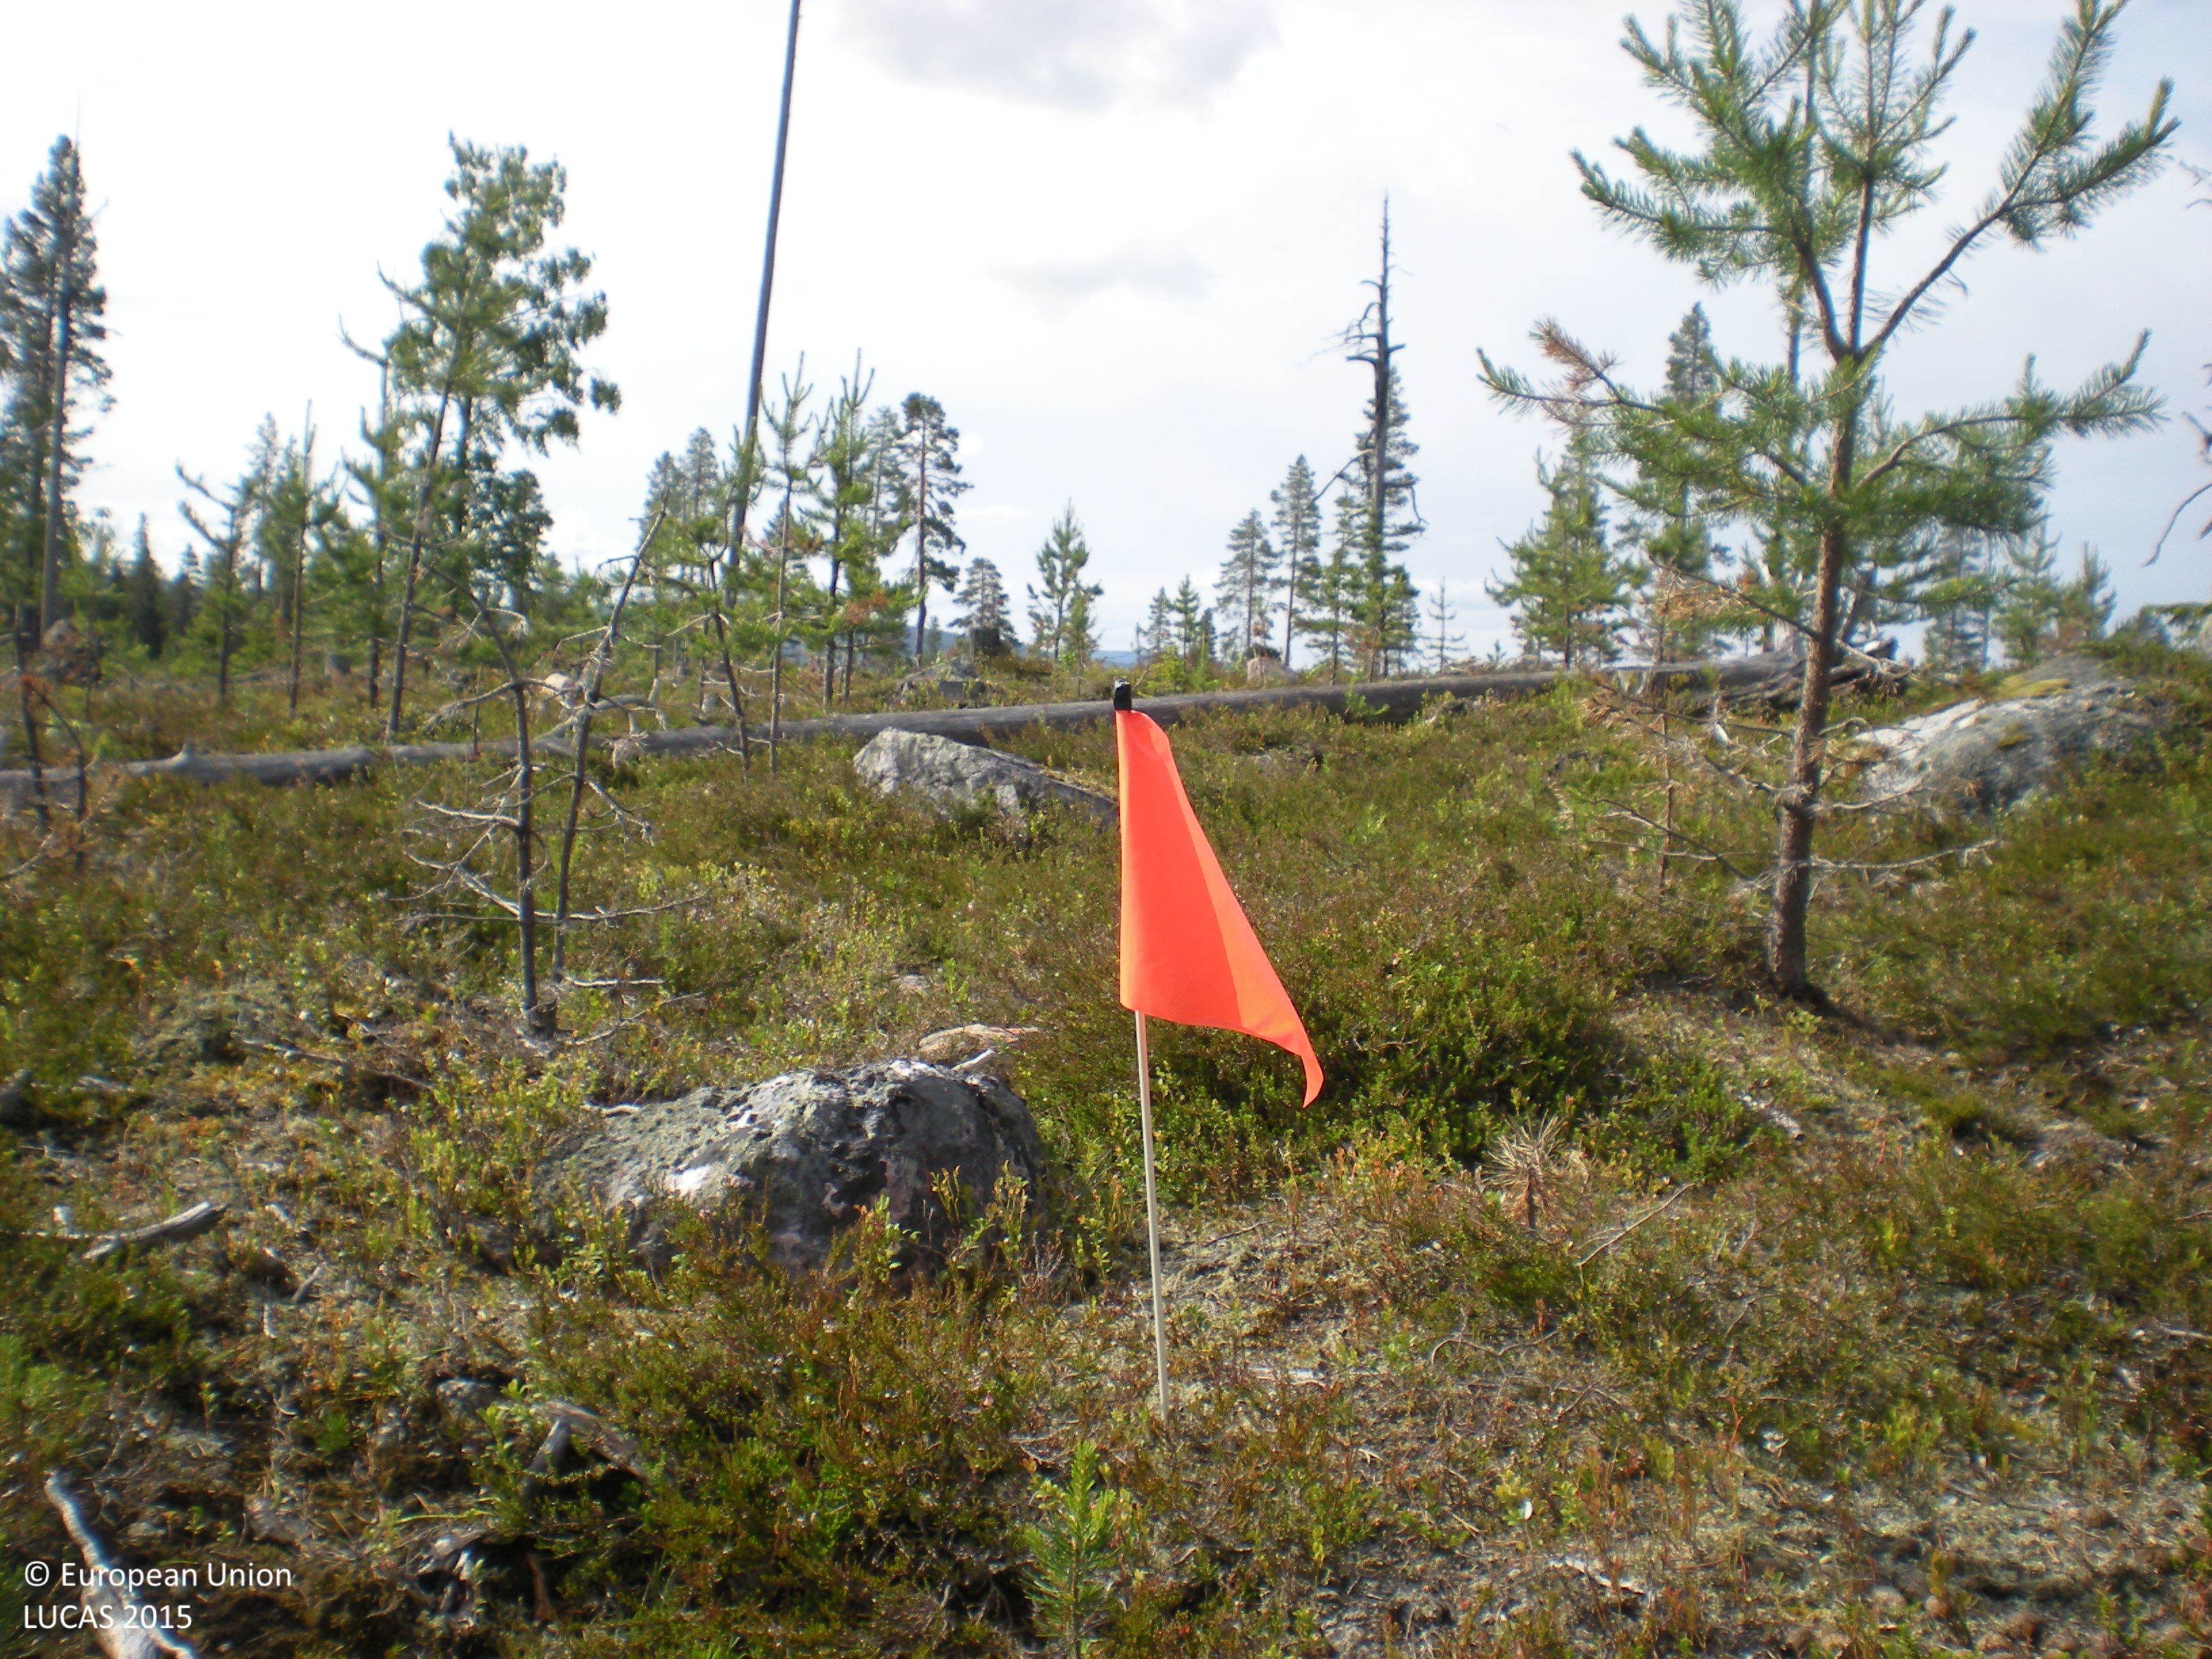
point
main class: Woodland
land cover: Pine dominated coniferous woodland
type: boreal forest
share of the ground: 10 - 25 %
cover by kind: shrubs 60 %, lichens and mosses 20 %, coniferous forest trees 10 %, consolidated bare surface 10 %
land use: Forestry
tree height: > 5 m
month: July
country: SE
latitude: 65.8000
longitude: 18.2868
